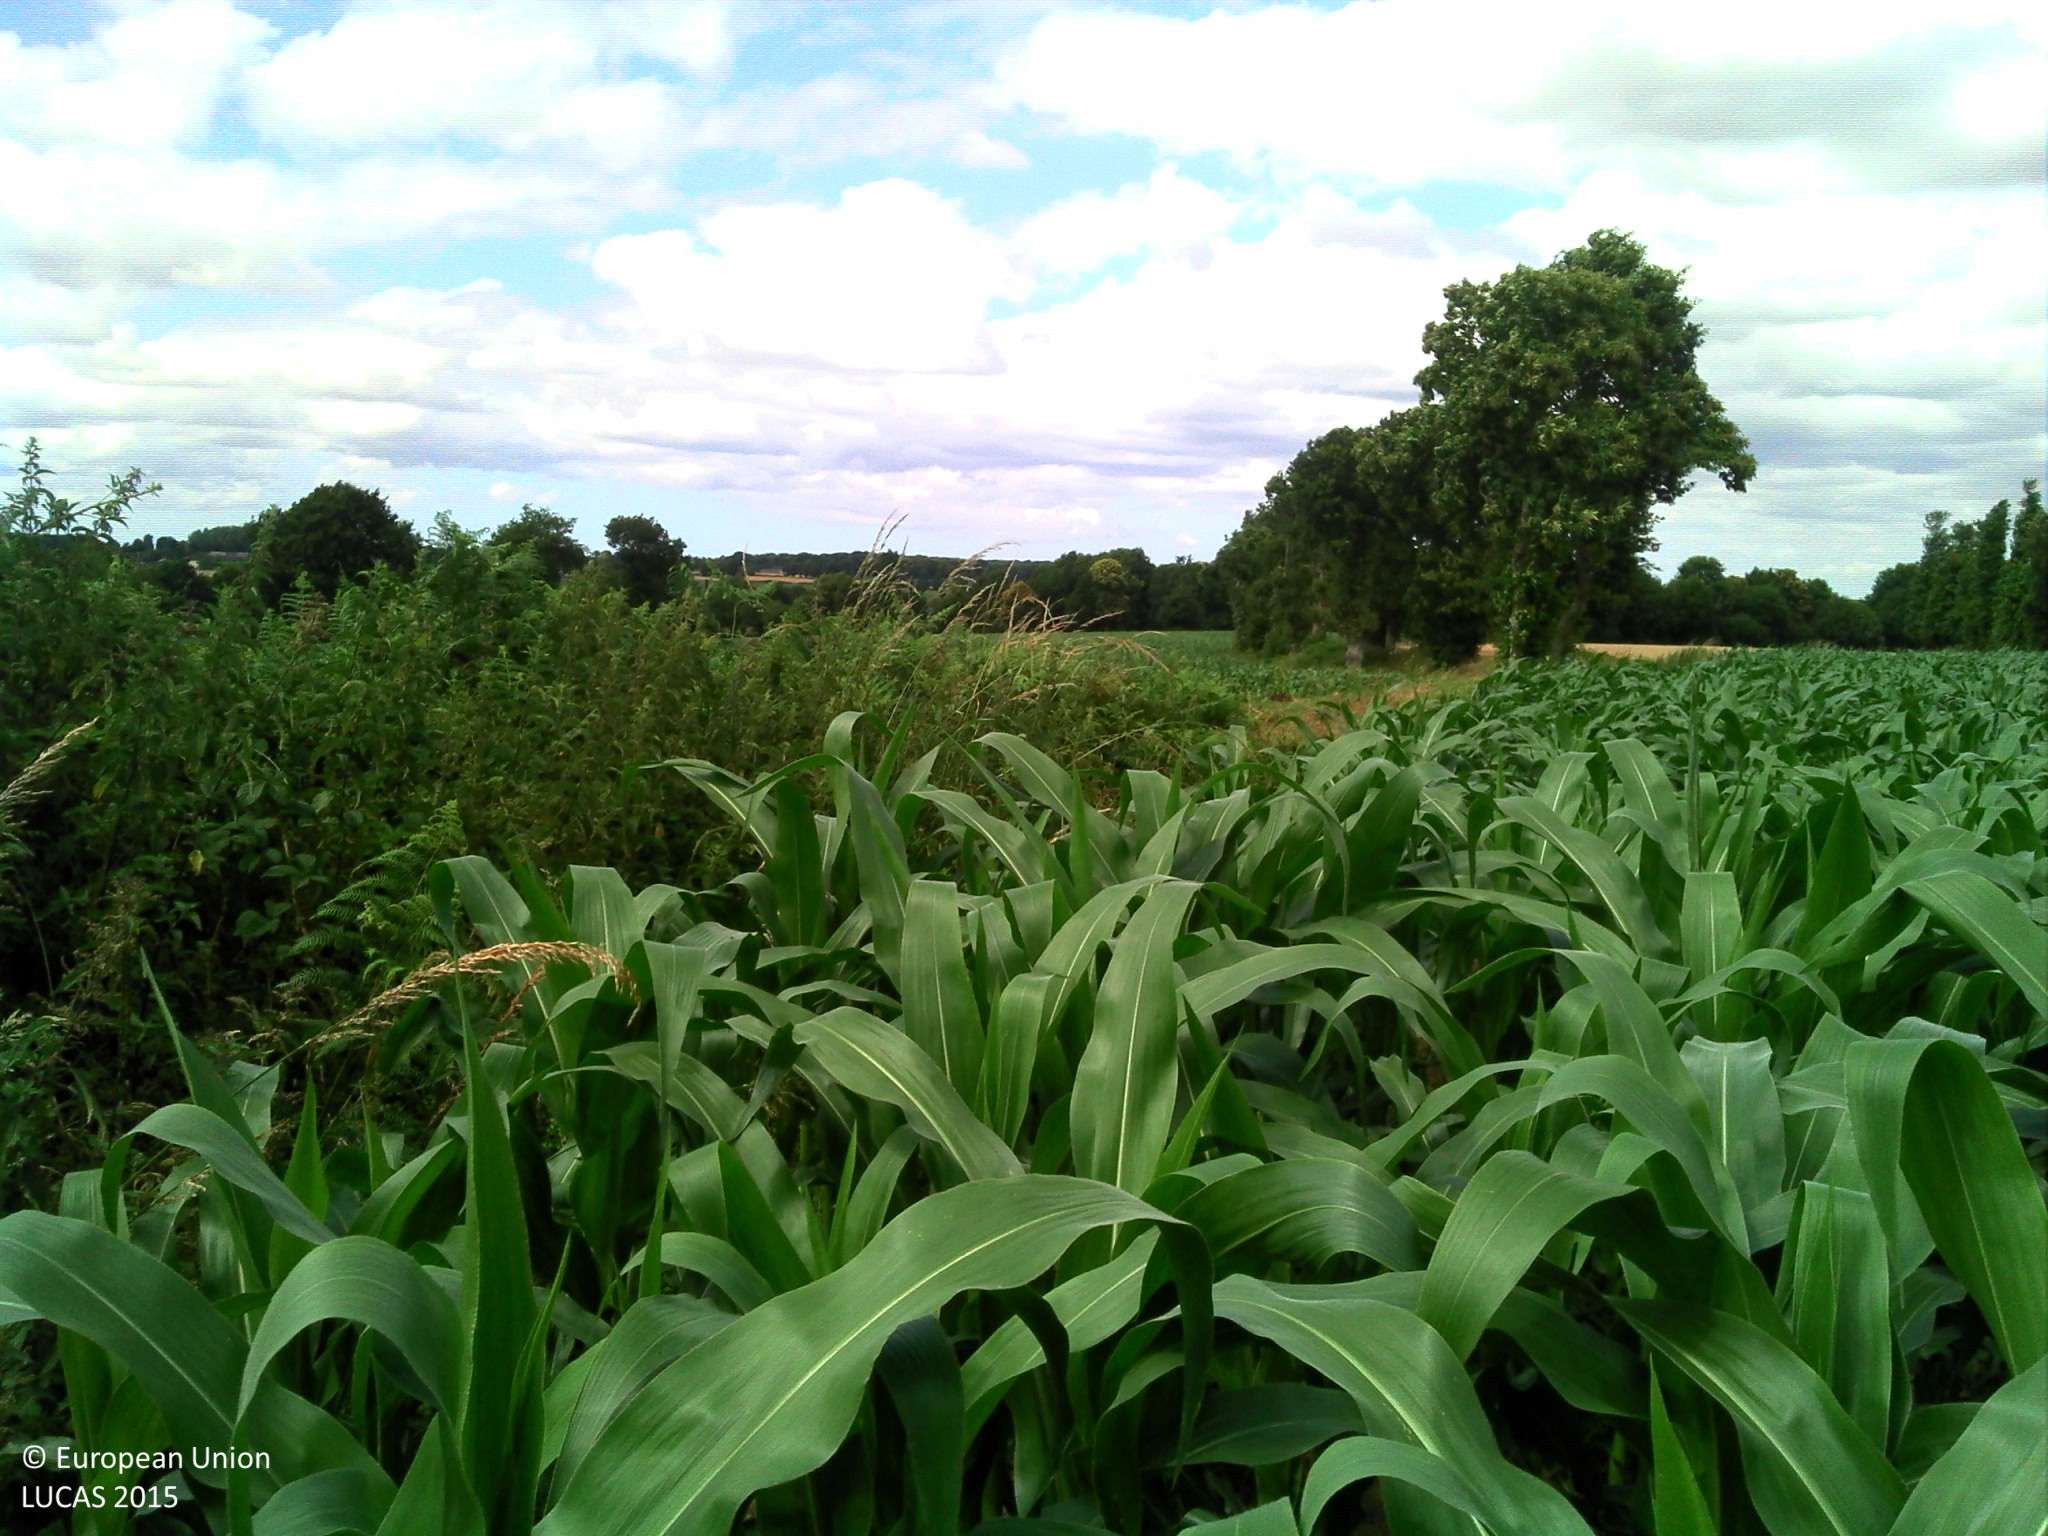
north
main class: Cropland
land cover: Maize
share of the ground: > 75 %
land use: Agriculture (excluding fallow land and kitchen gardens)
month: July
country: FR
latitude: 48.2034
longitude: -2.1516
